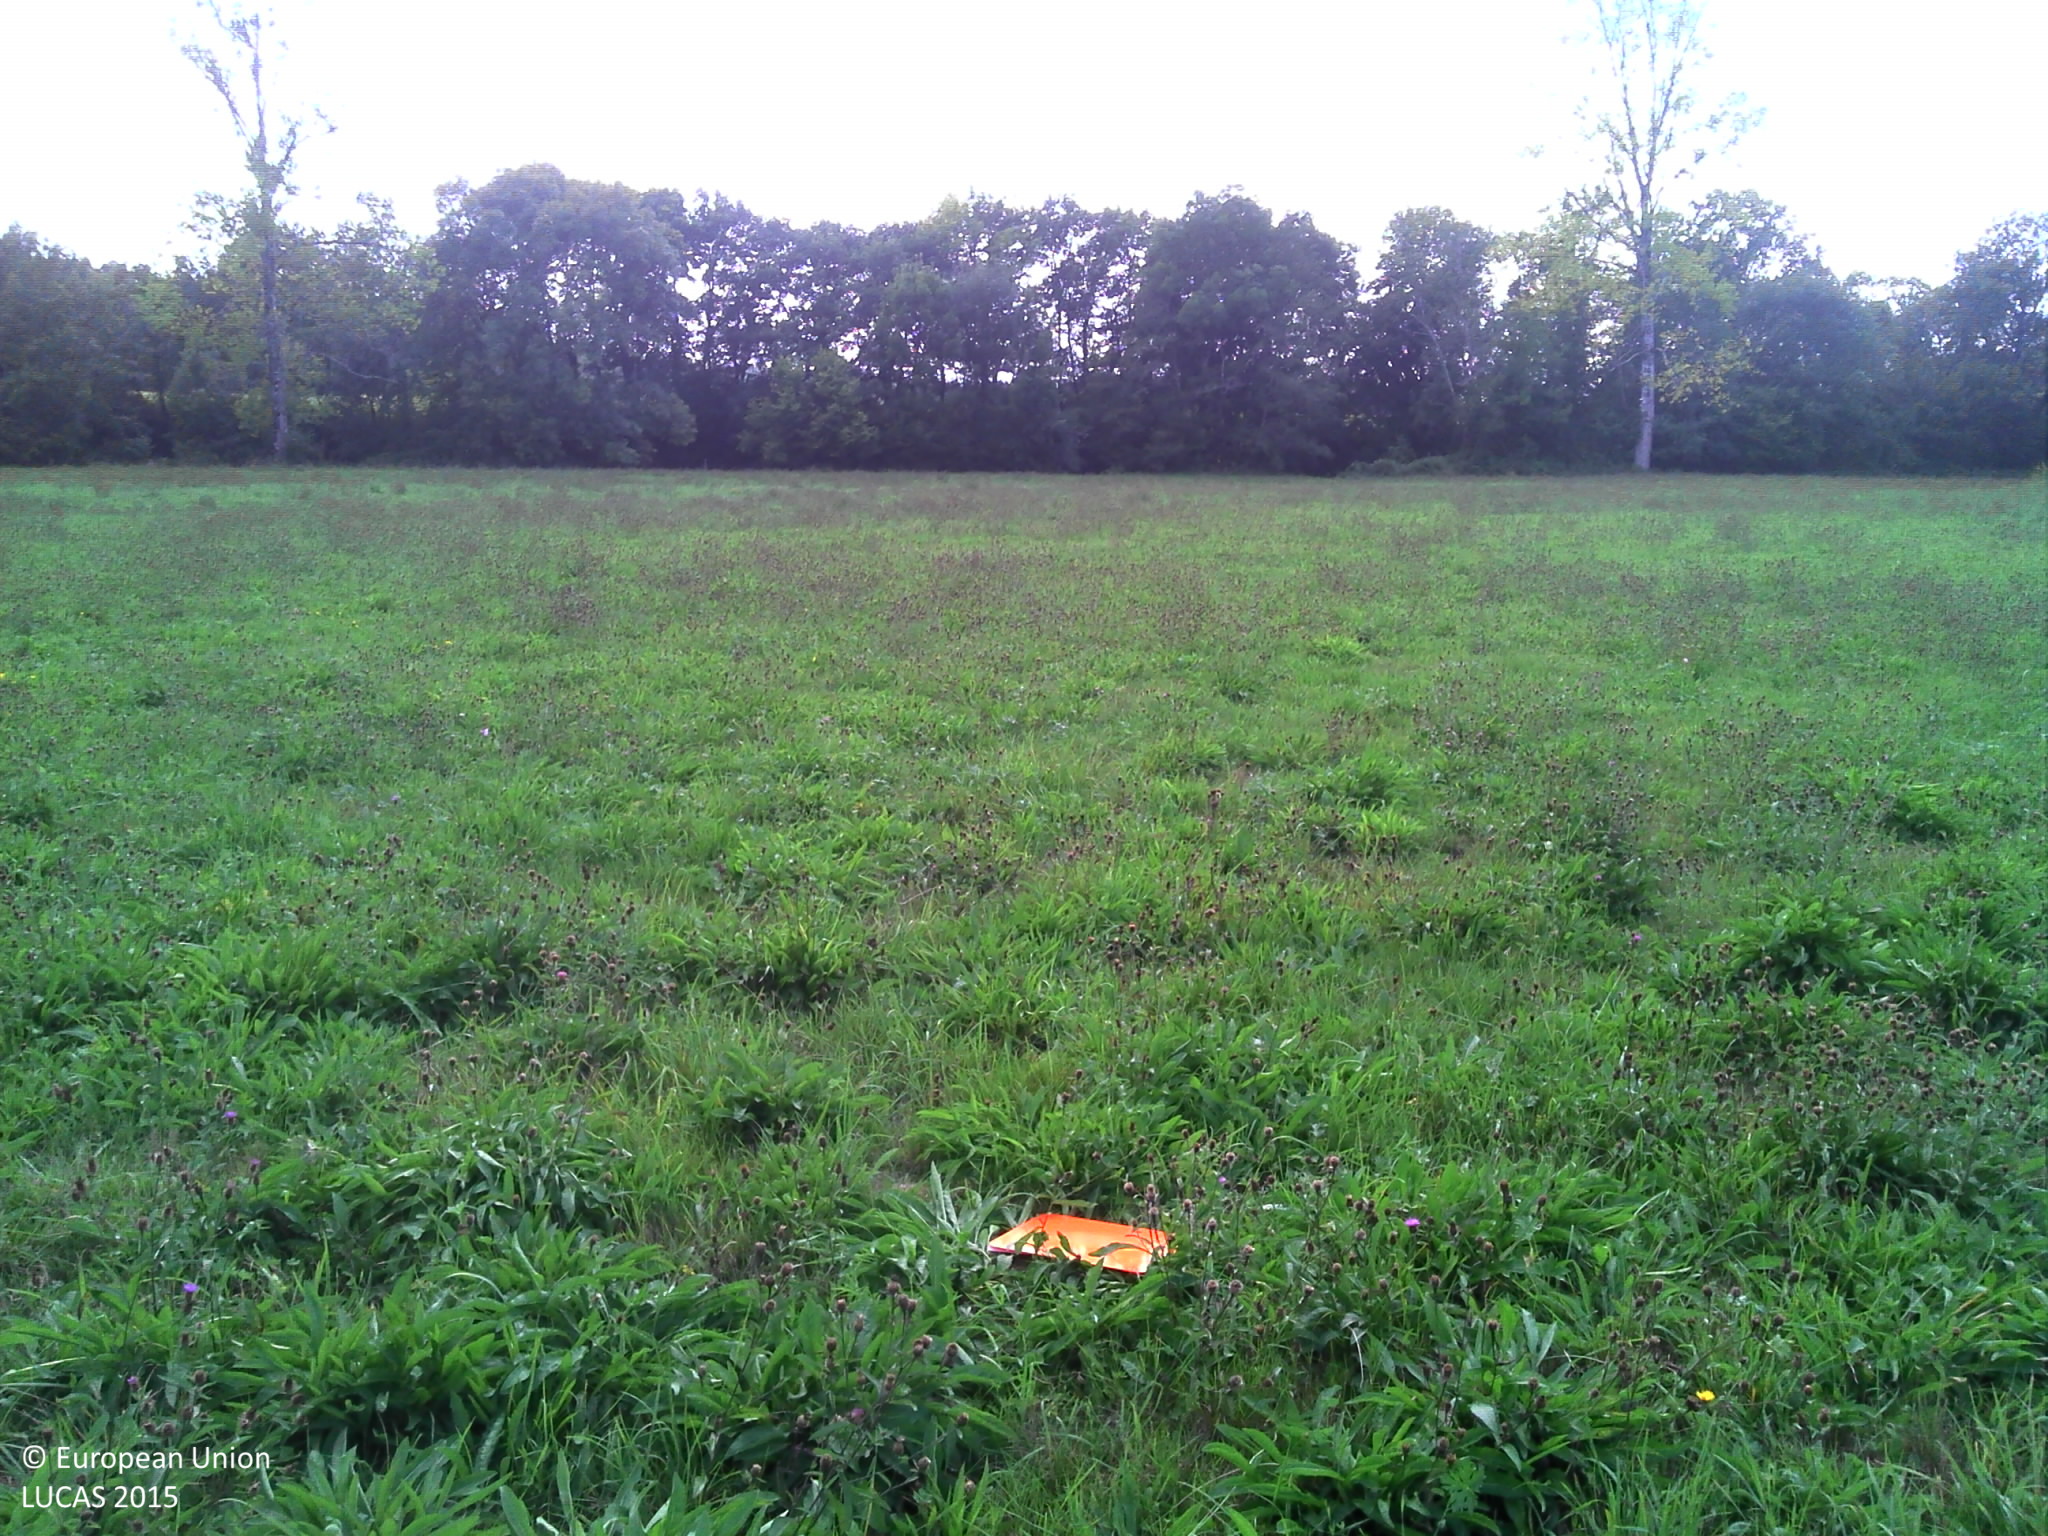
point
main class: Grassland
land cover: Grassland without tree/shrub cover
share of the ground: > 75 %
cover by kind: herbaceous plants 90 %, lichens and mosses 5 %, consolidated bare surface 5 %
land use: Agriculture (excluding fallow land and kitchen gardens)
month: August
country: FR
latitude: 45.3680
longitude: 0.7327
